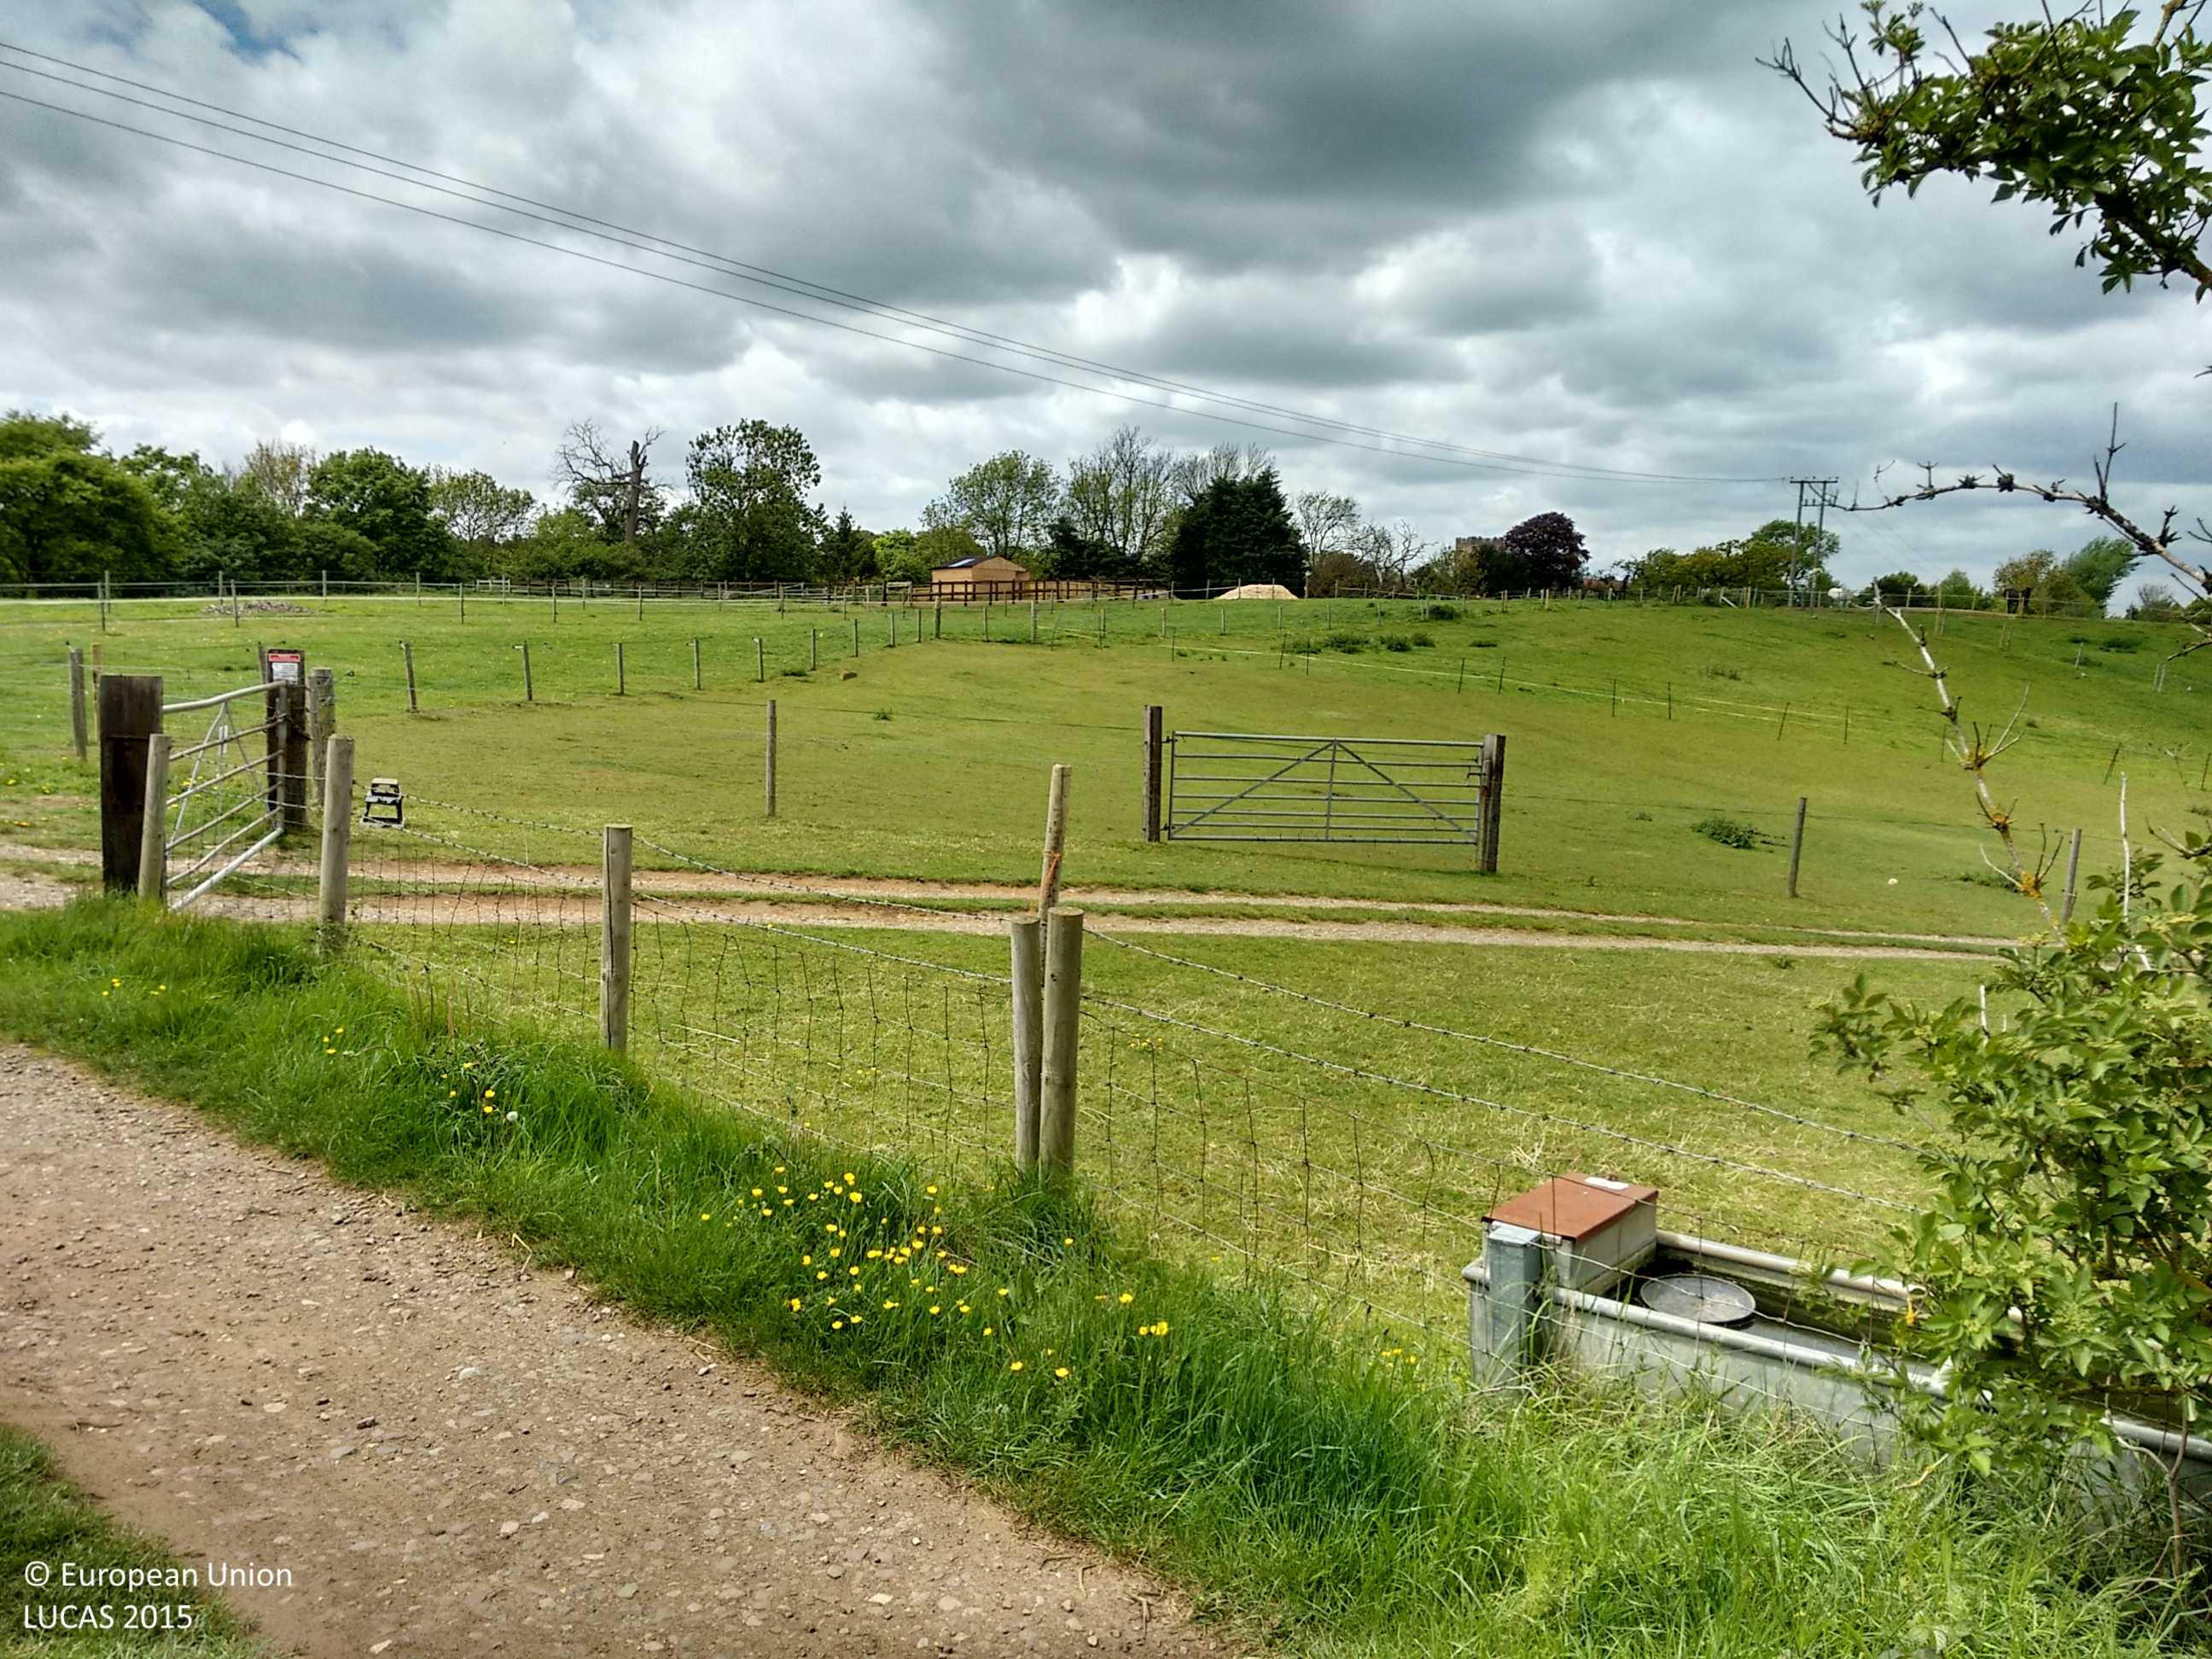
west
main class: Grassland
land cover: Grassland without tree/shrub cover
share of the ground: > 75 %
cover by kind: herbaceous plants 100 %
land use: Amenities, museums, leisure
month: May
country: GB
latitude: 52.0356
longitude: -0.5197
